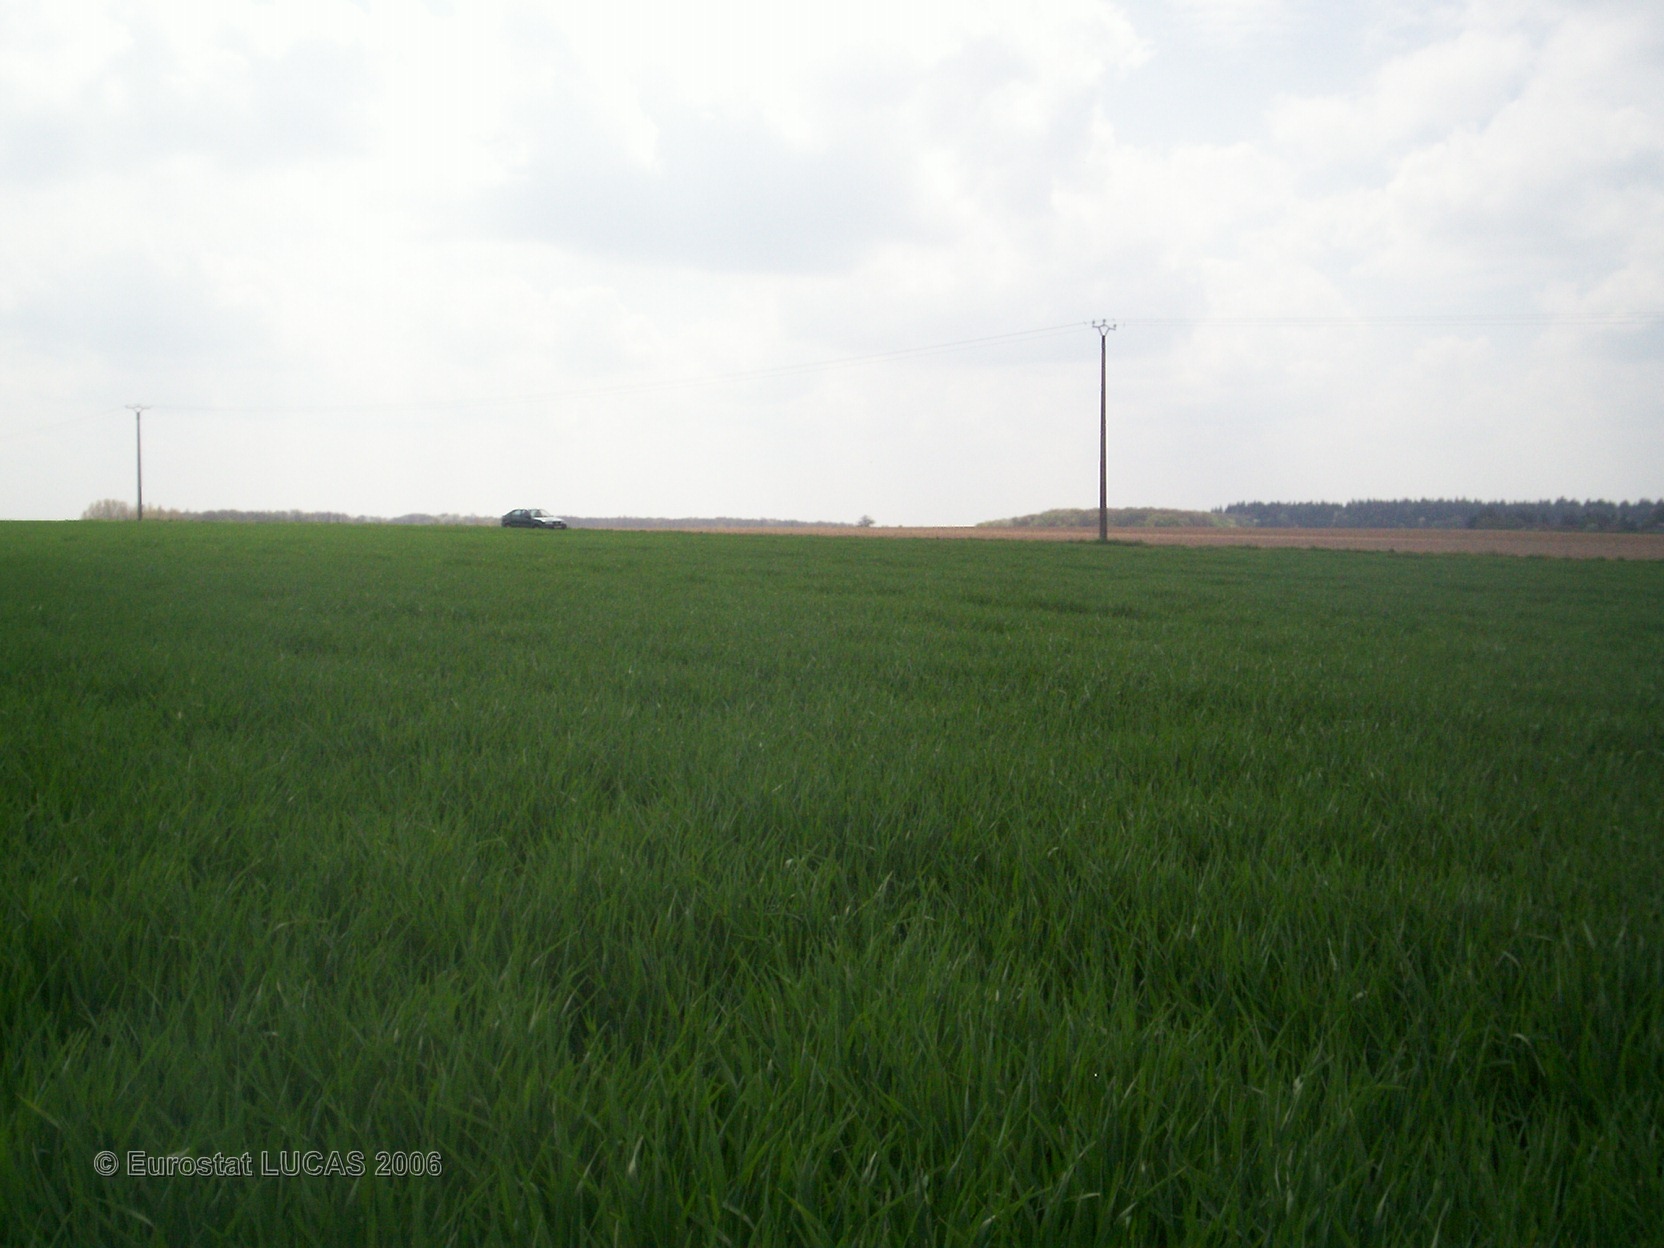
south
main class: Cropland
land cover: Barley
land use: Agriculture (excluding fallow land and kitchen gardens)
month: April
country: FR
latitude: 47.8248
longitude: 0.8571
